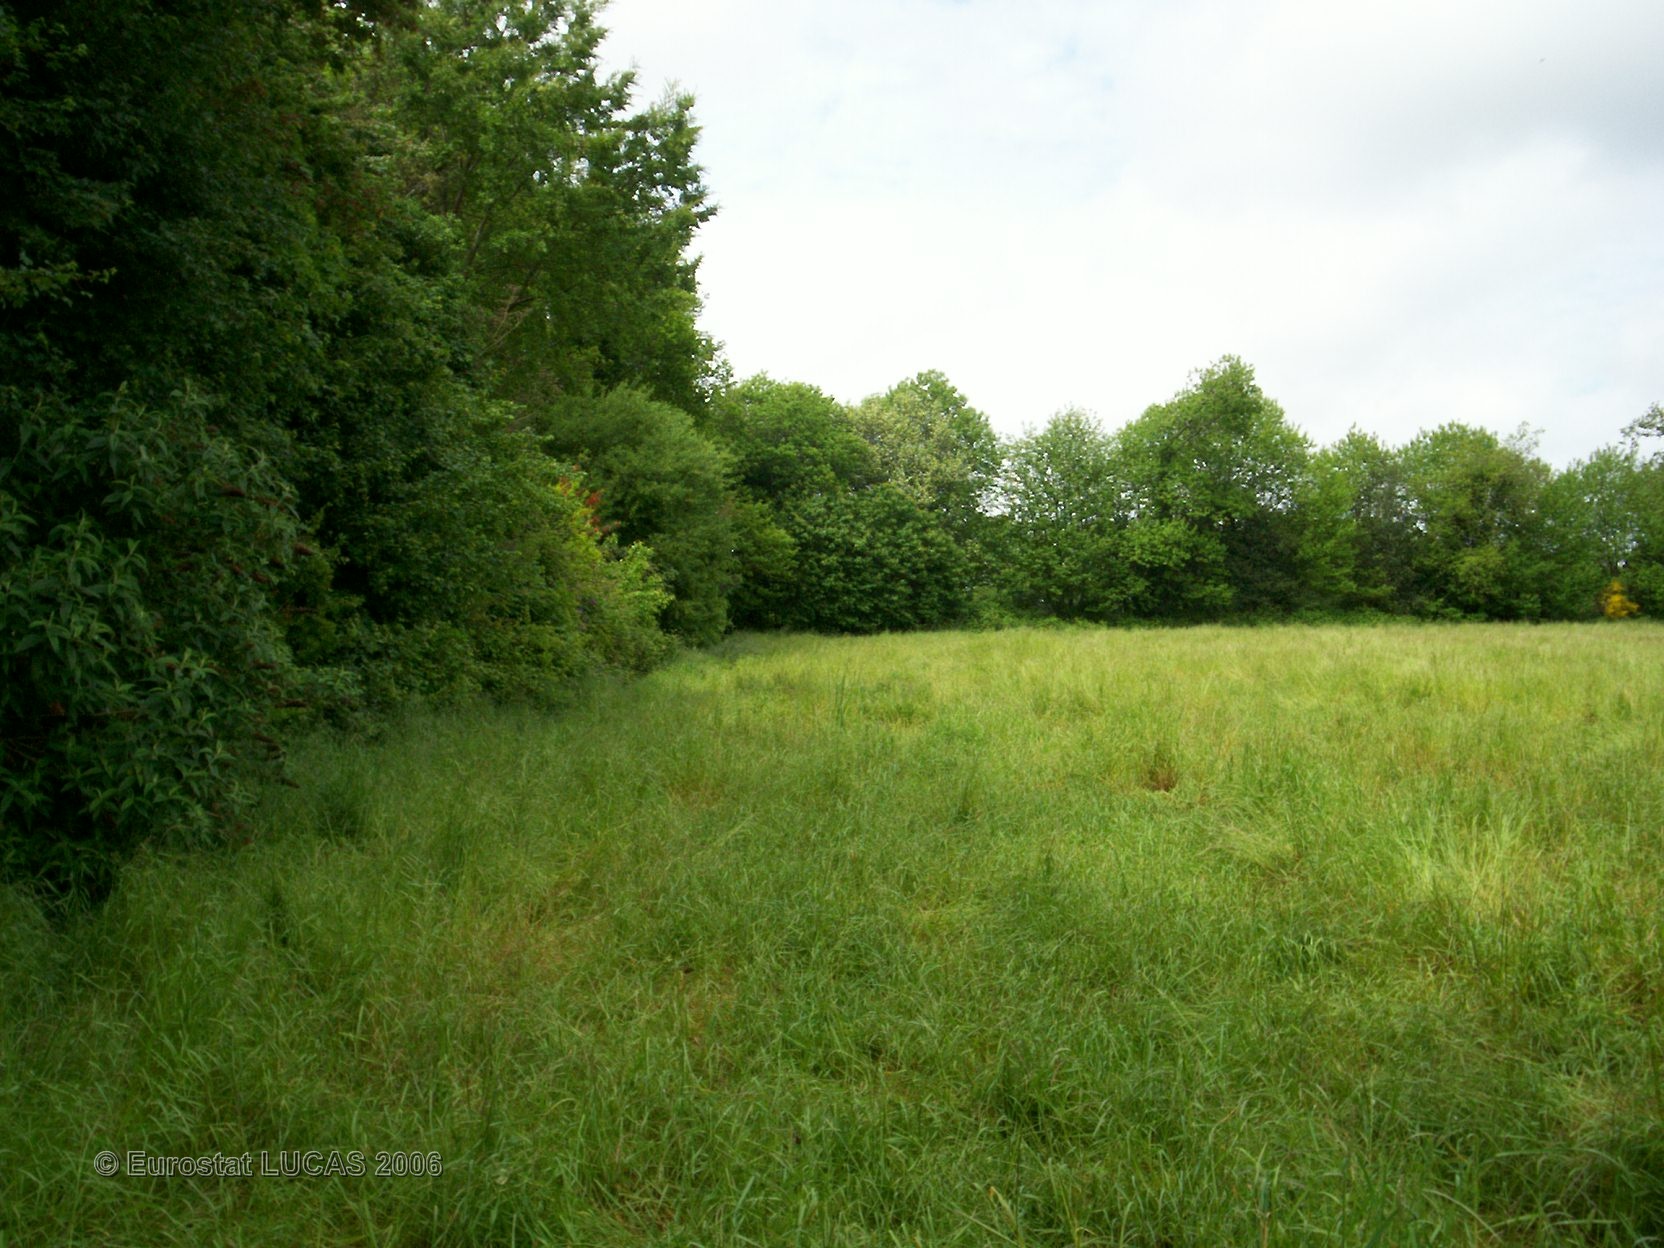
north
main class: Grassland
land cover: Grassland without tree/shrub cover
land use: Agriculture (excluding fallow land and kitchen gardens)
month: May
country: FR
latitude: 47.9145
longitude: -3.5240
